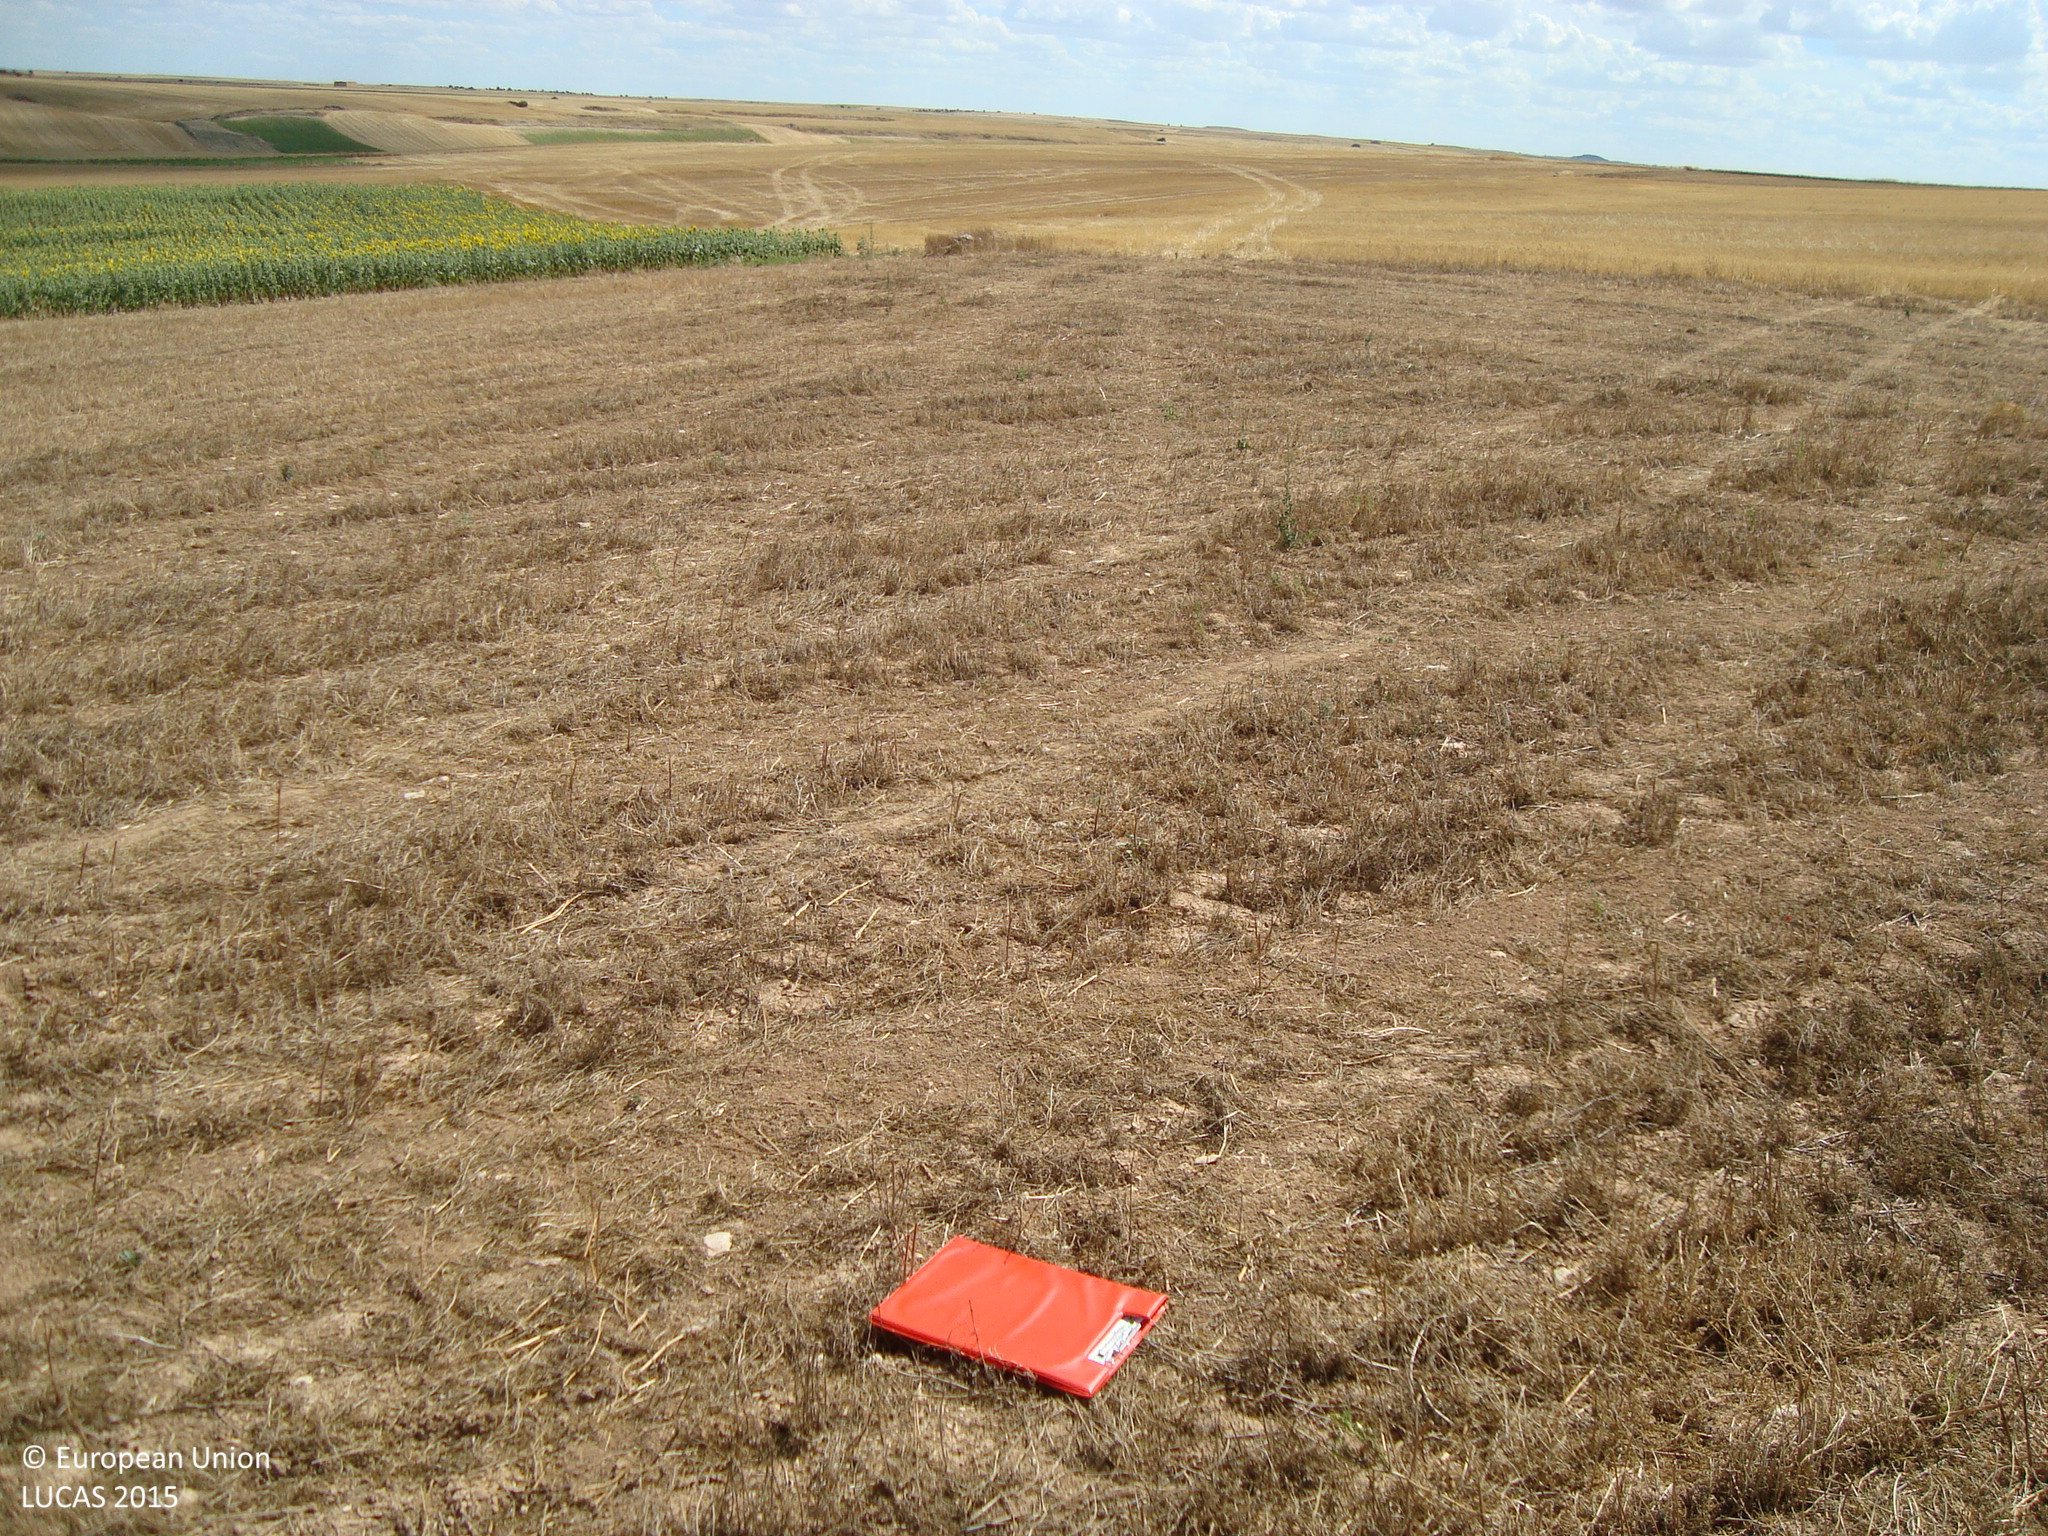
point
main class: Cropland
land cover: Dry pulses
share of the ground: > 75 %
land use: Agriculture (excluding fallow land and kitchen gardens)
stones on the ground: < 10 %
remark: Harvested field
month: July
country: ES
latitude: 41.9328
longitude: -3.8673
